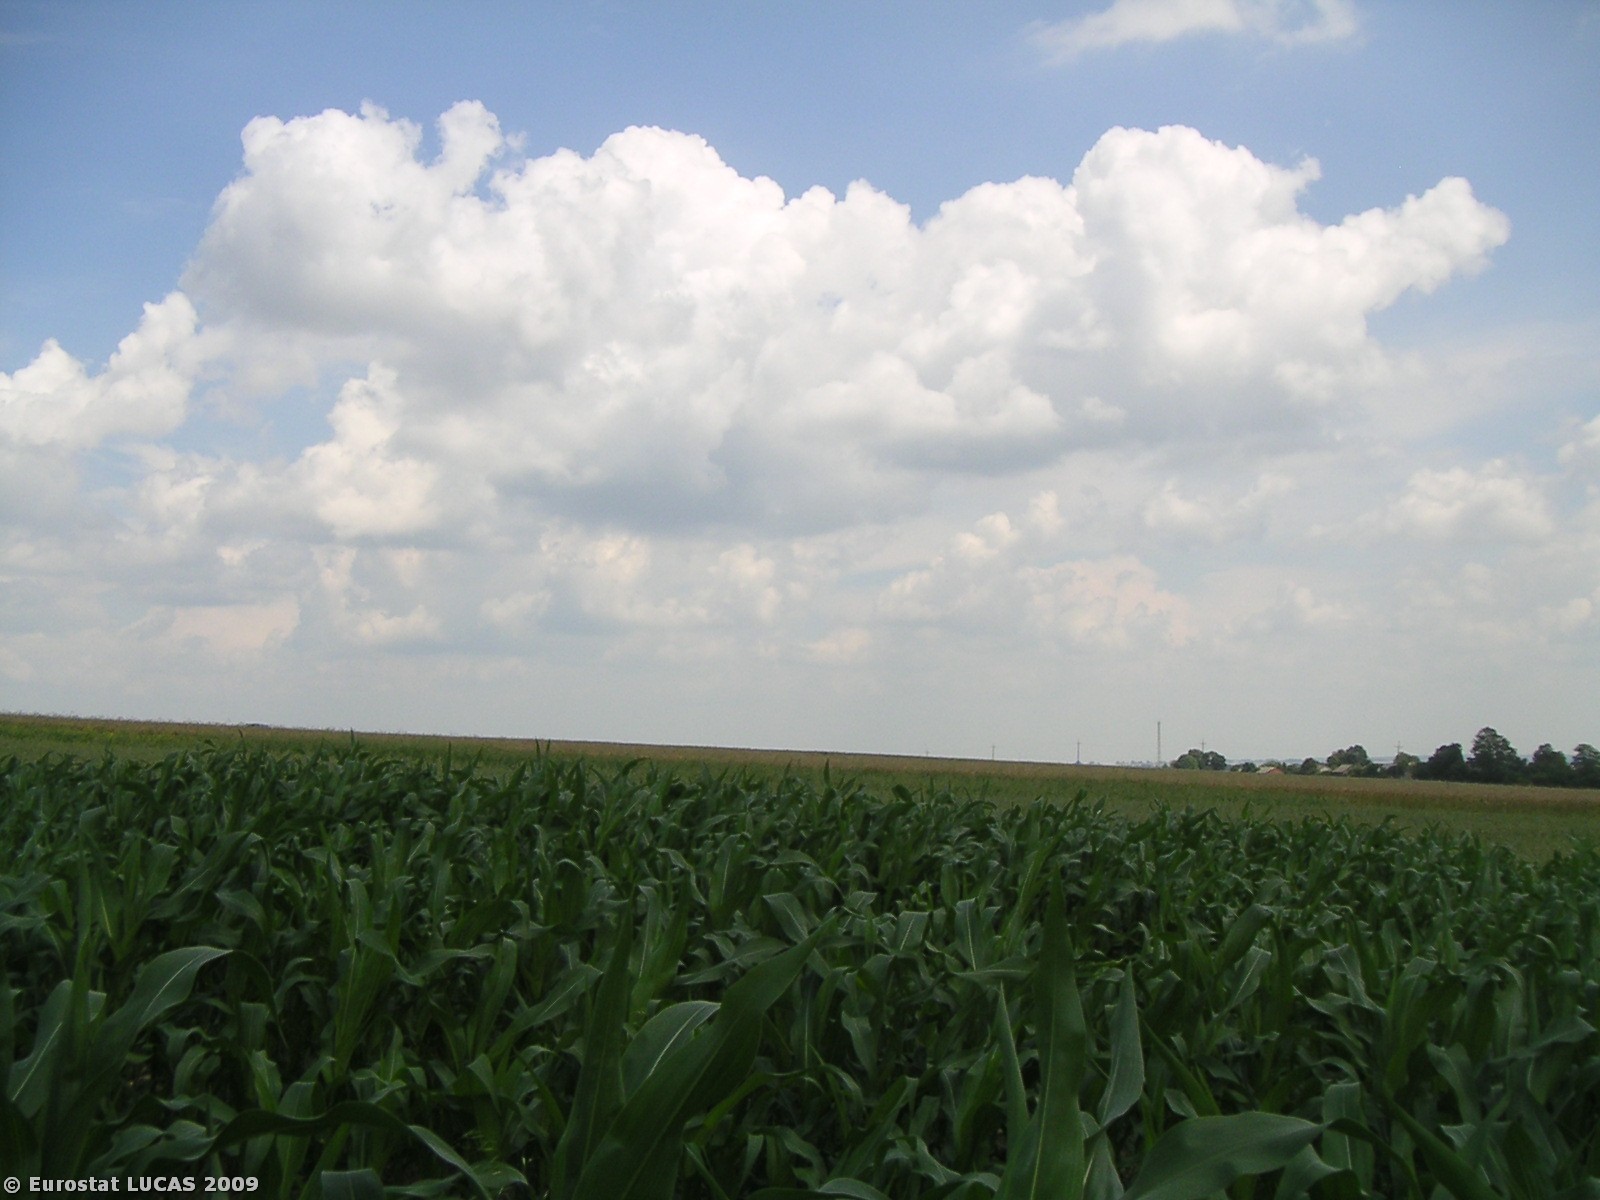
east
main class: Cropland
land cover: Maize
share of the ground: > 75 %
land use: Agriculture (excluding fallow land and kitchen gardens)
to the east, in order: Maize; Oats; Grassland without tree/shrub cover; Oats; Triticale; Paved roads, cycling and walking lanes; Maize; Potatoes; Common wheat
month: July
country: PL
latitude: 50.5085
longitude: 19.7455
